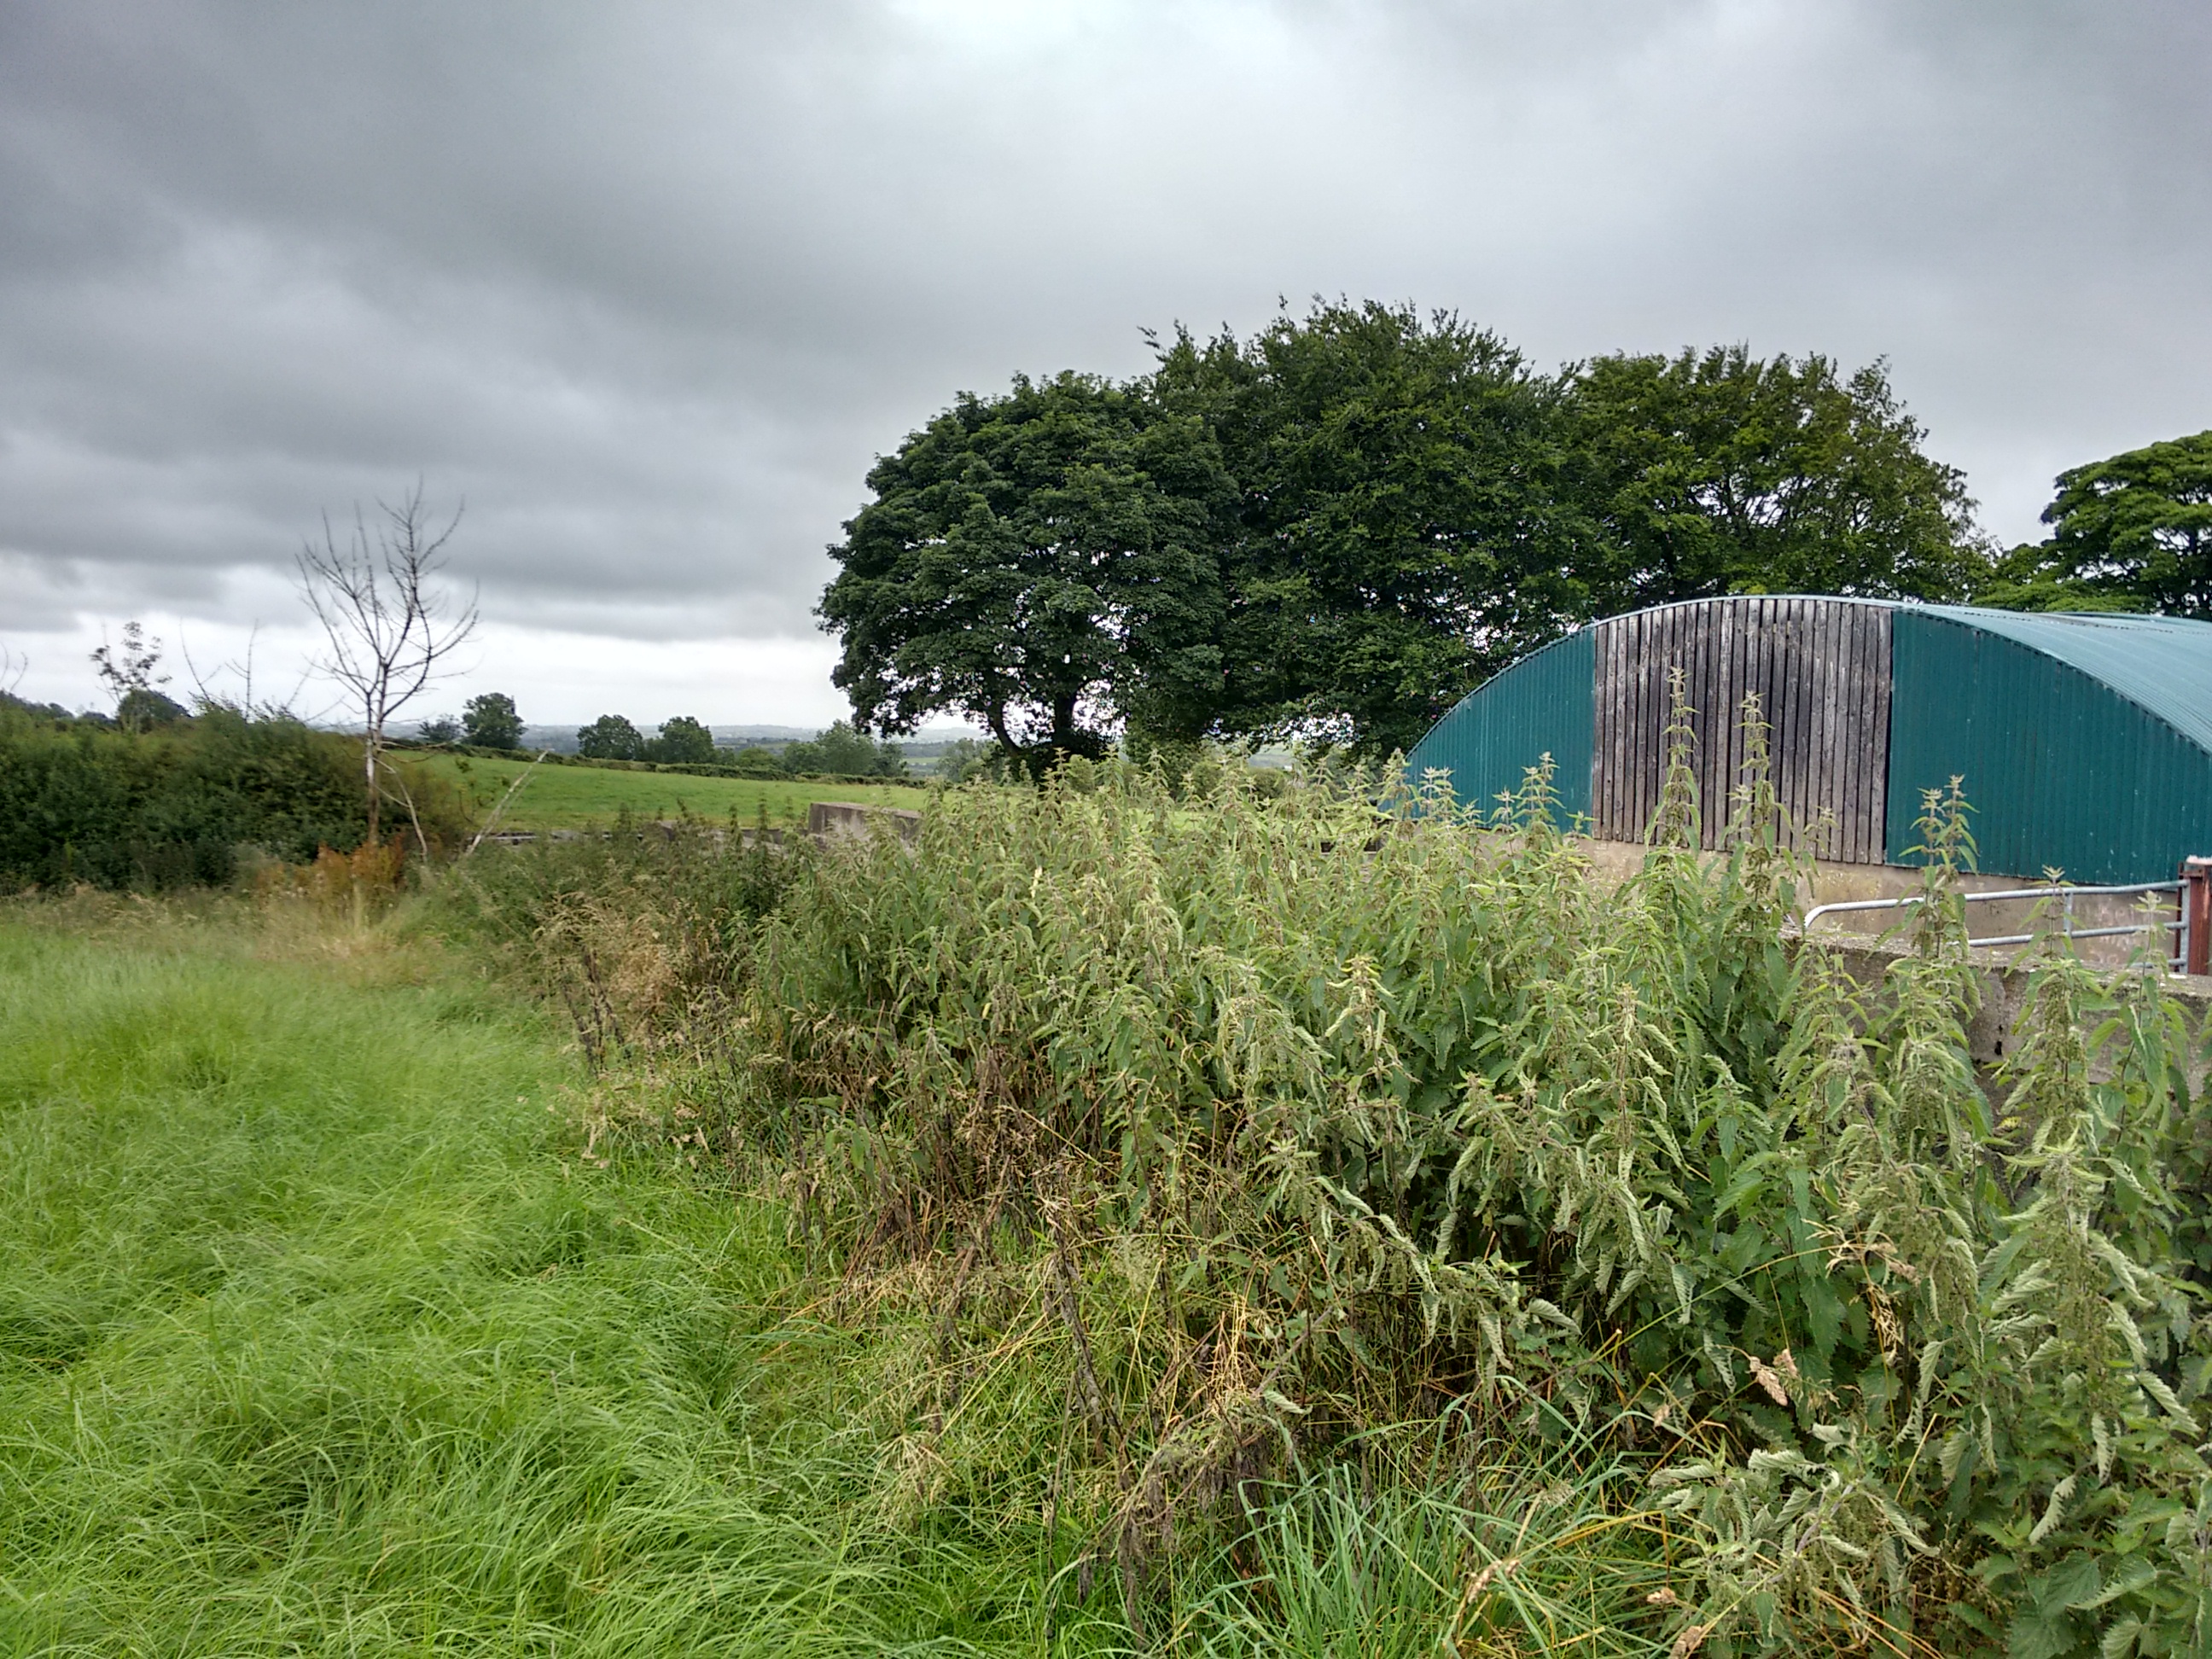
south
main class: Grassland
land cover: Grassland without tree/shrub cover
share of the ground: > 75 %
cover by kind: herbaceous plants 100 %
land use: Agriculture (excluding fallow land and kitchen gardens)
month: August
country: GB
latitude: 54.6115
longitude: -6.9050
